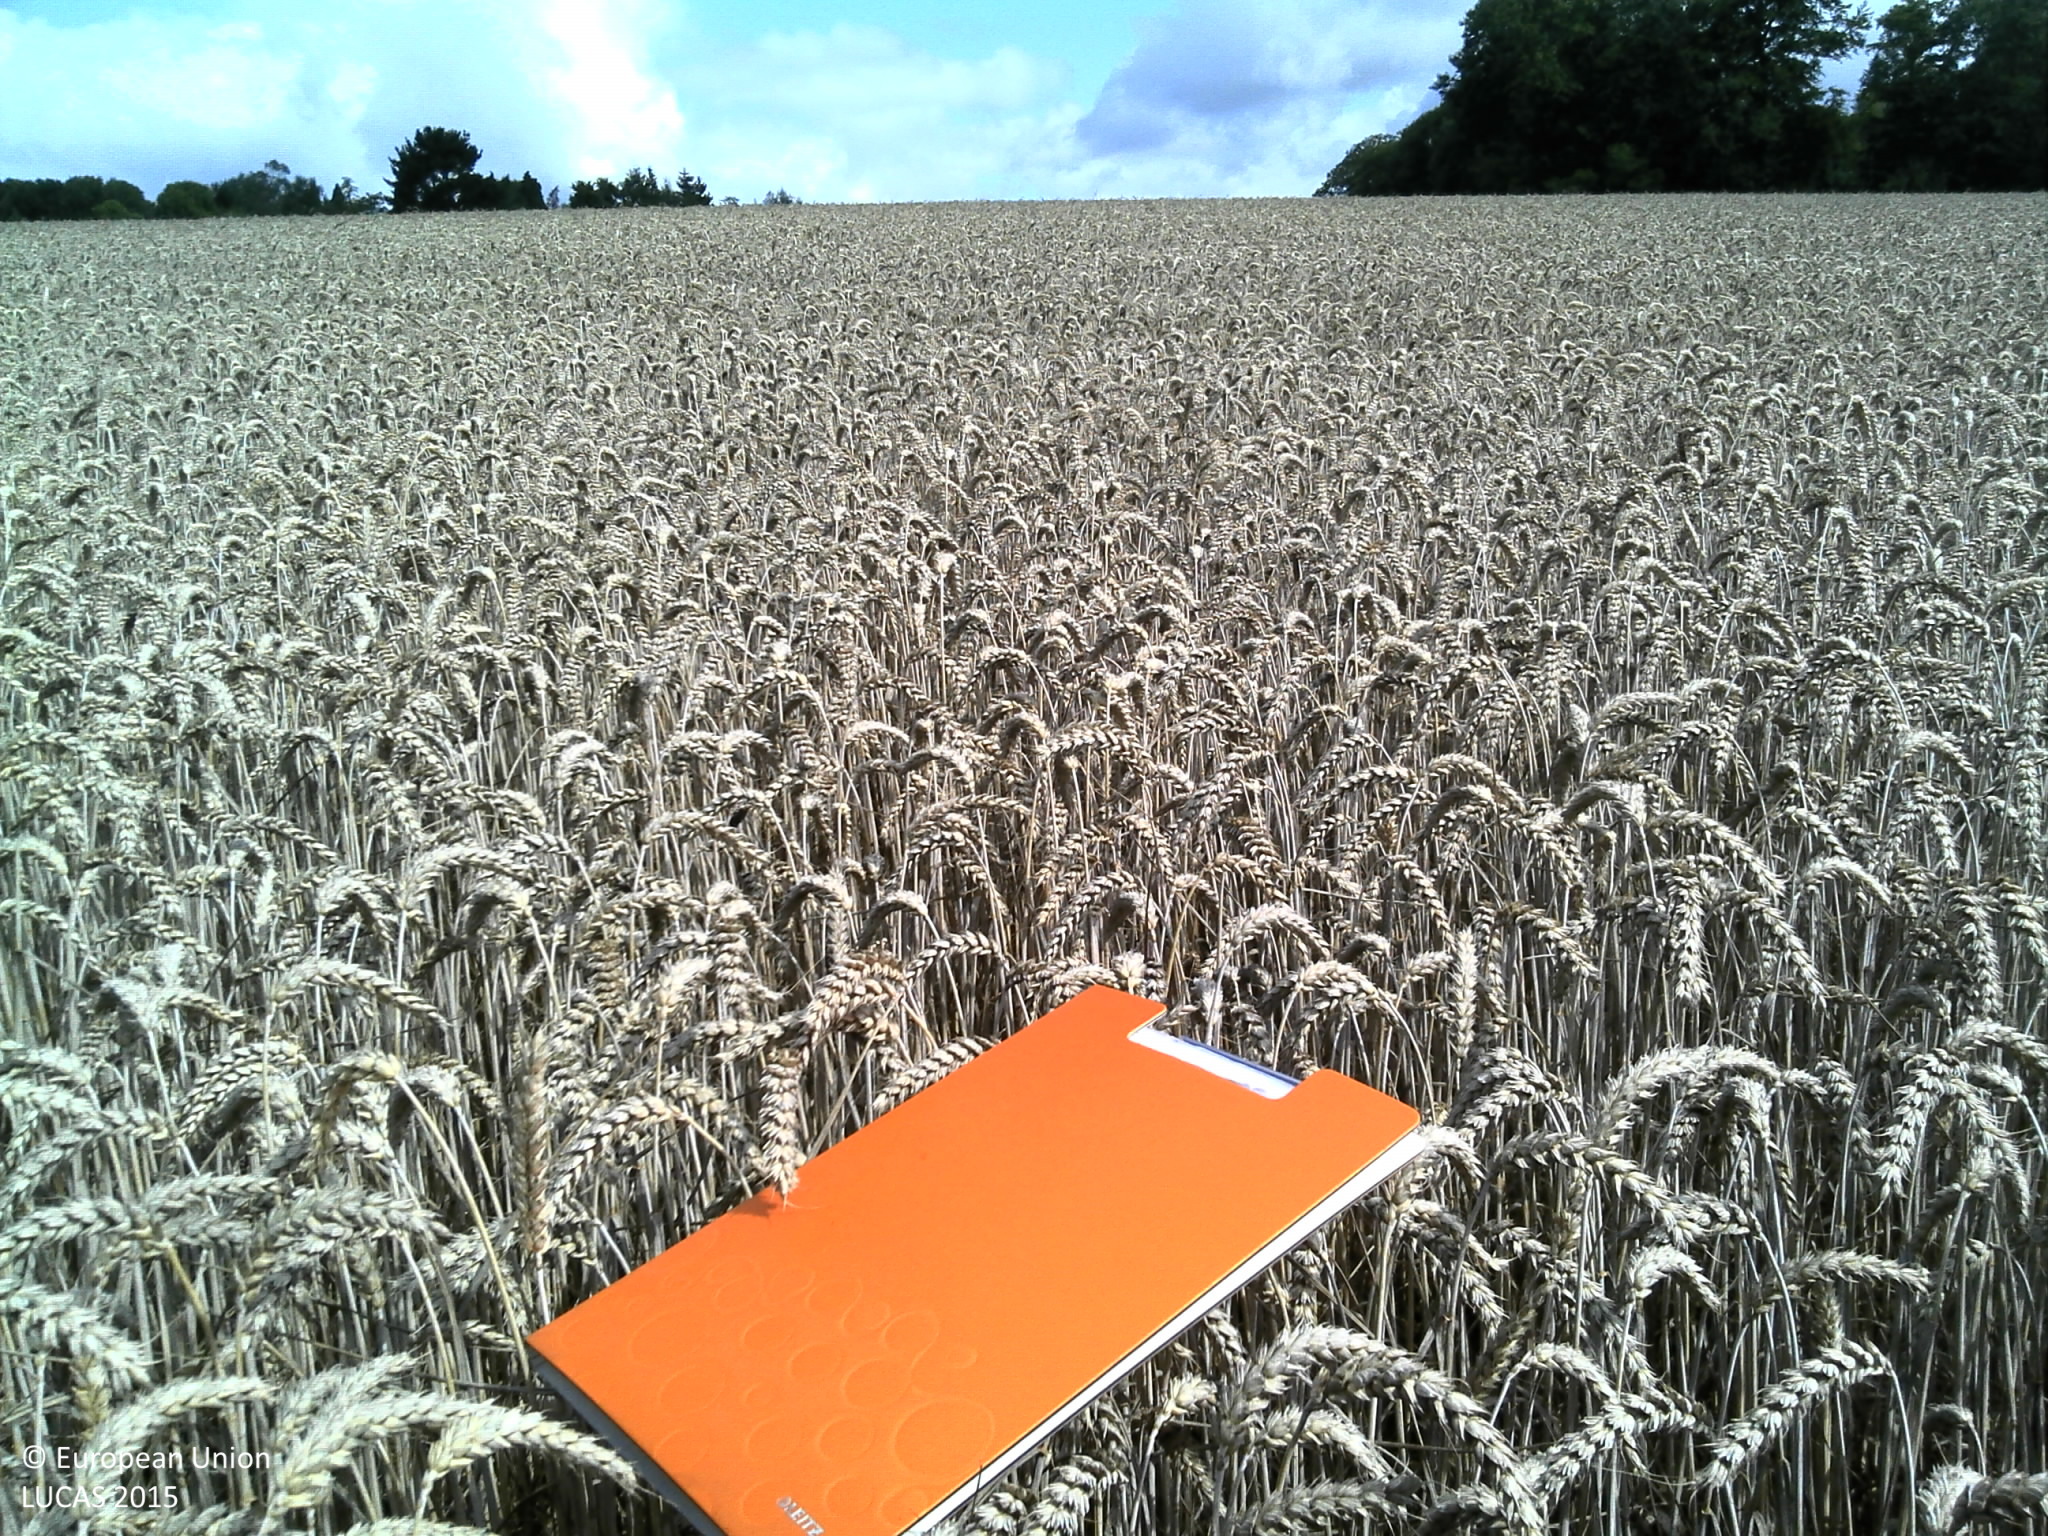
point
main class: Cropland
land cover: Common wheat
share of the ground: > 75 %
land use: Agriculture (excluding fallow land and kitchen gardens)
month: July
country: FR
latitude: 48.3456
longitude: -3.7238
